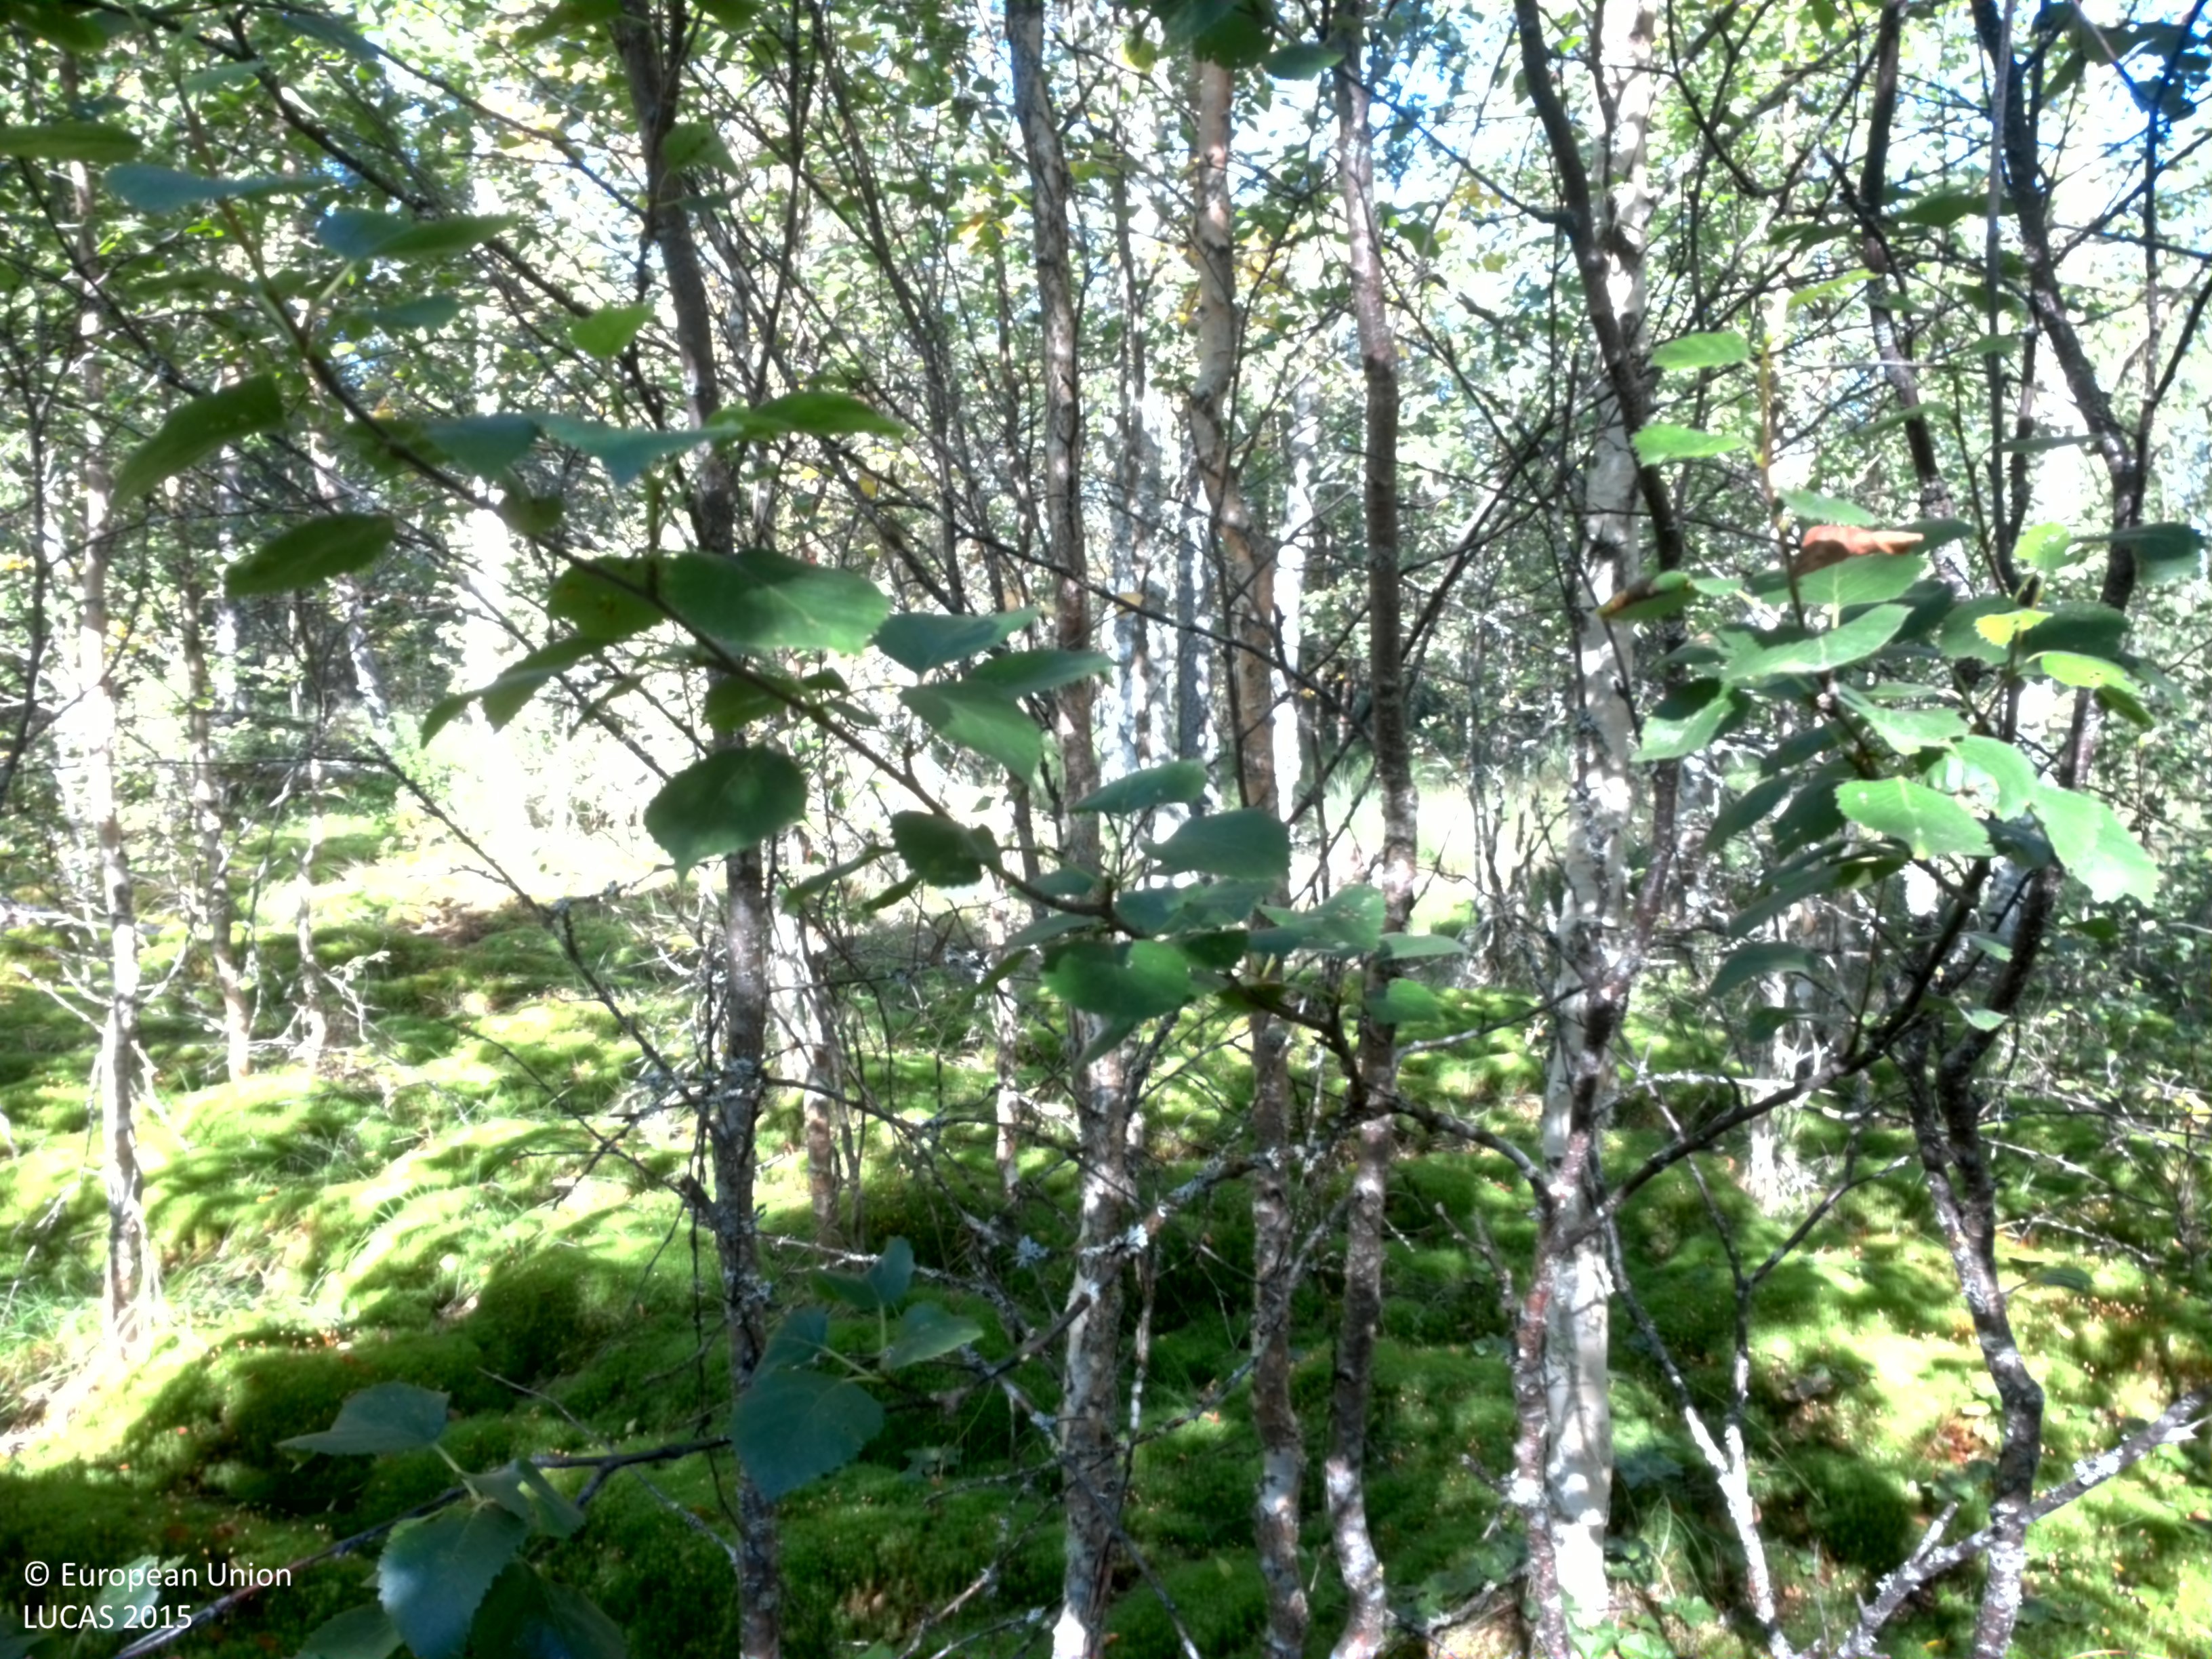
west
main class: Woodland
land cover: Broadleaved woodland
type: boreal forest
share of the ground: 50 - 75 %
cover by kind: broadleaved forest trees 75 %, lichens and mosses 25 %
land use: Forestry
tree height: < 5 m
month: August
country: SE
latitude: 64.2905
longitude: 18.6271
